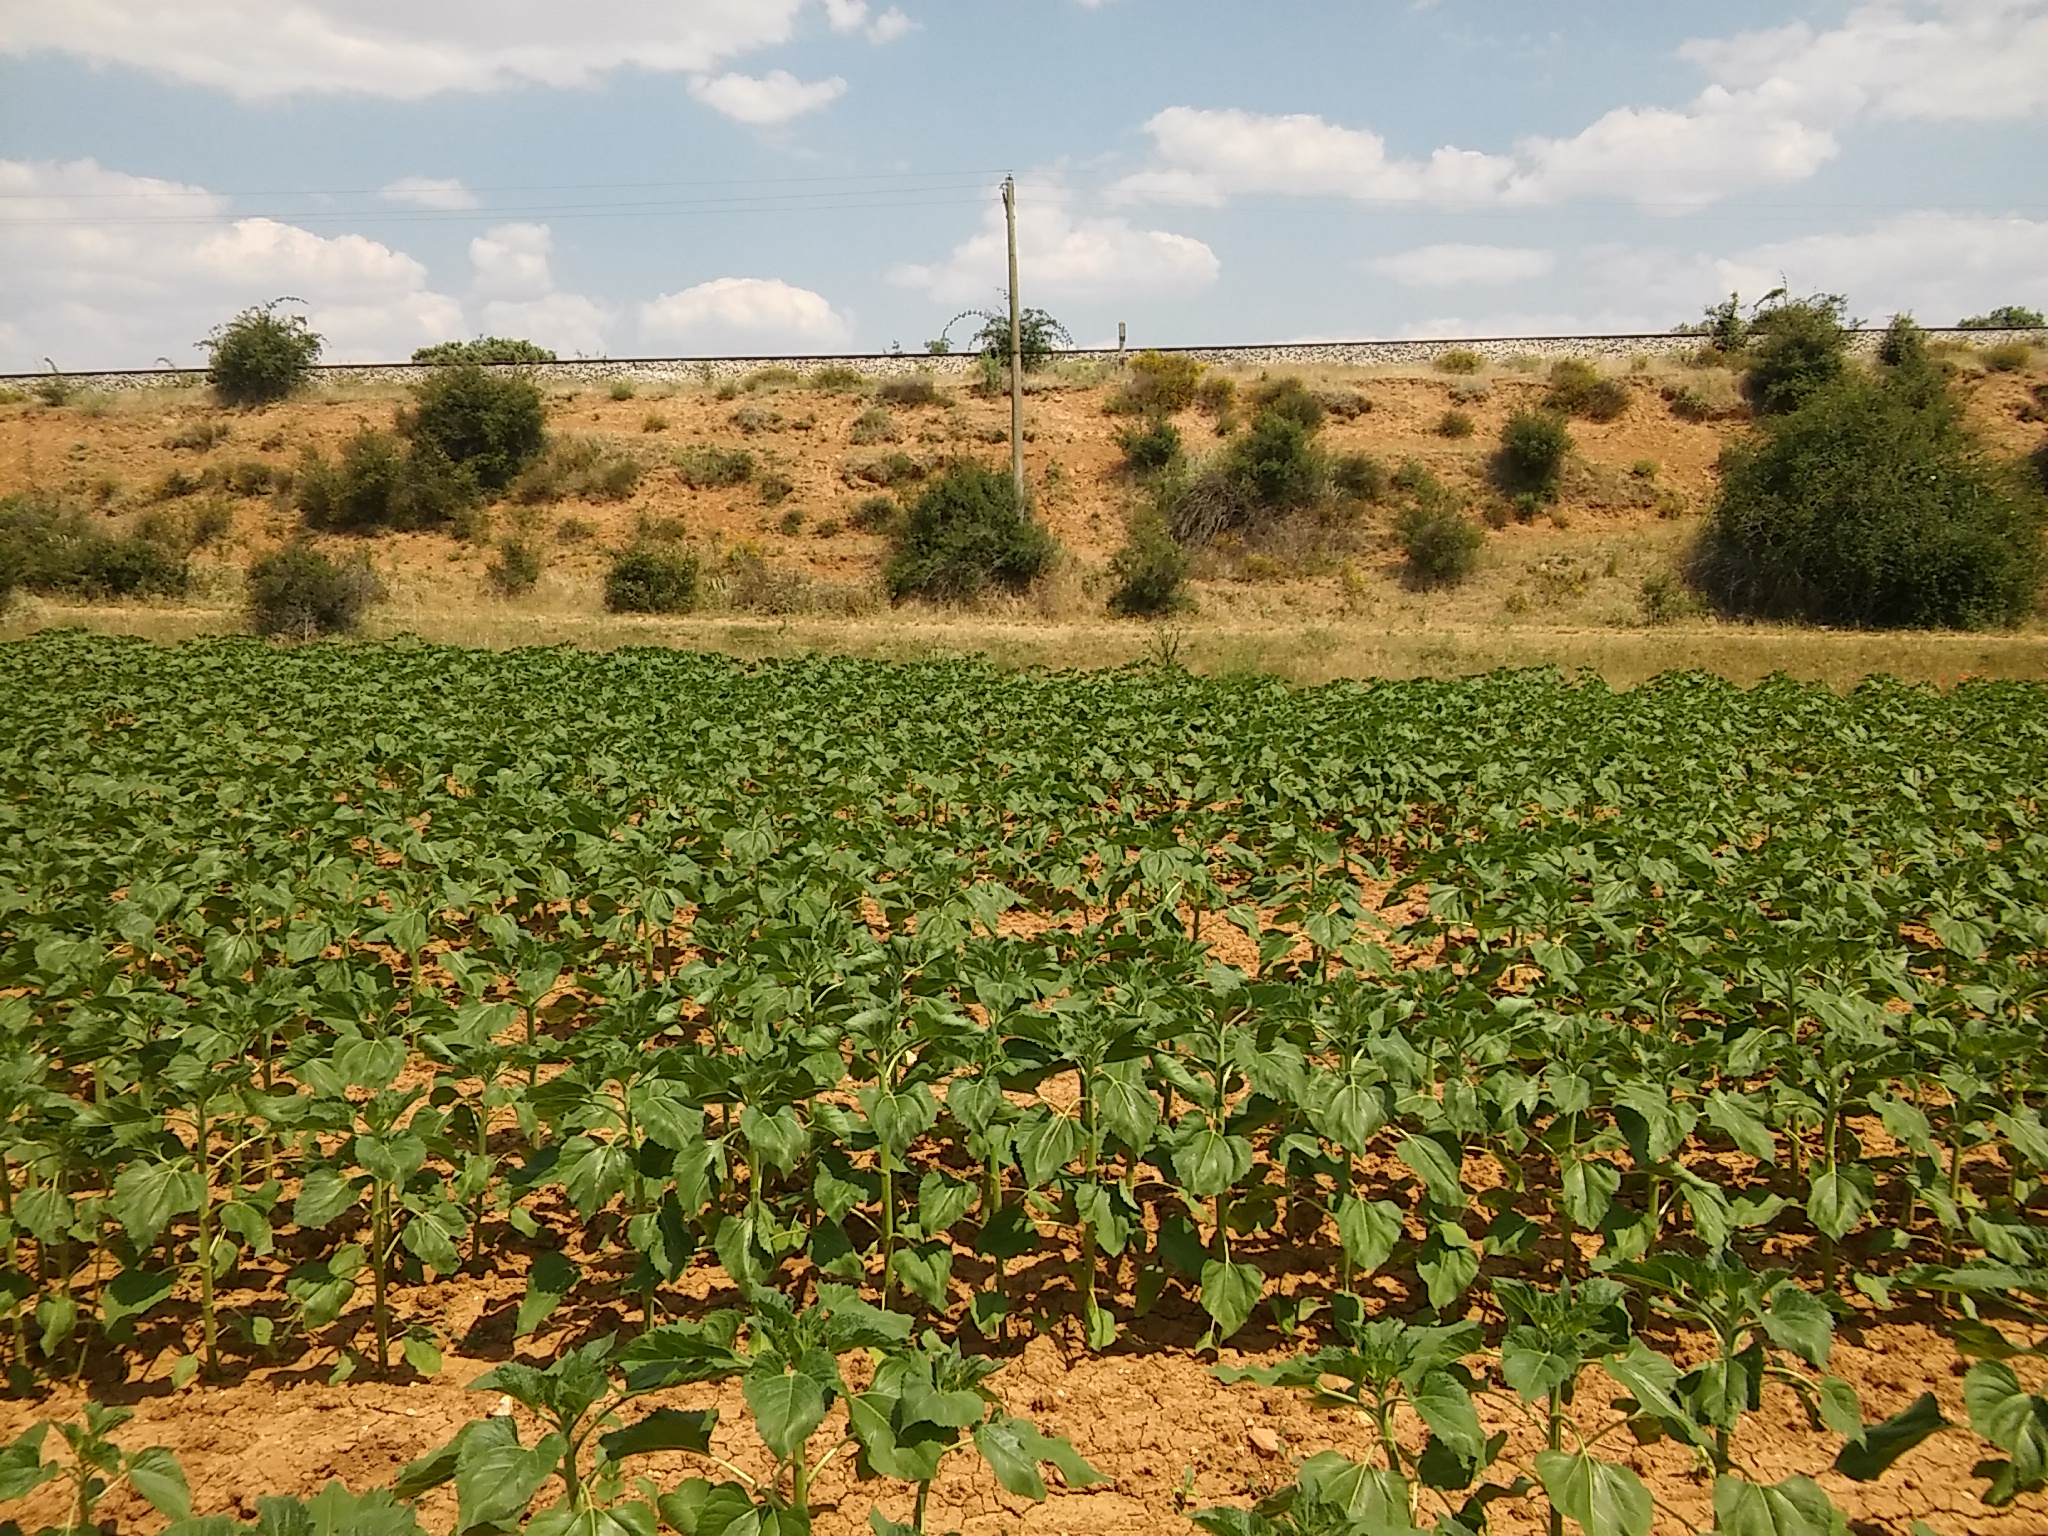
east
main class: Cropland
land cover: Sunflower
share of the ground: 50 - 75 %
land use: Agriculture (excluding fallow land and kitchen gardens)
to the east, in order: Sunflower; Spontaneously vegetated surfaces; Tracks; Shrubland without tree cover; Electric lines; Shrubland without tree cover; Railways; Broadleaved woodland; Sunflower
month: June
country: ES
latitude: 41.4058
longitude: -3.5773
